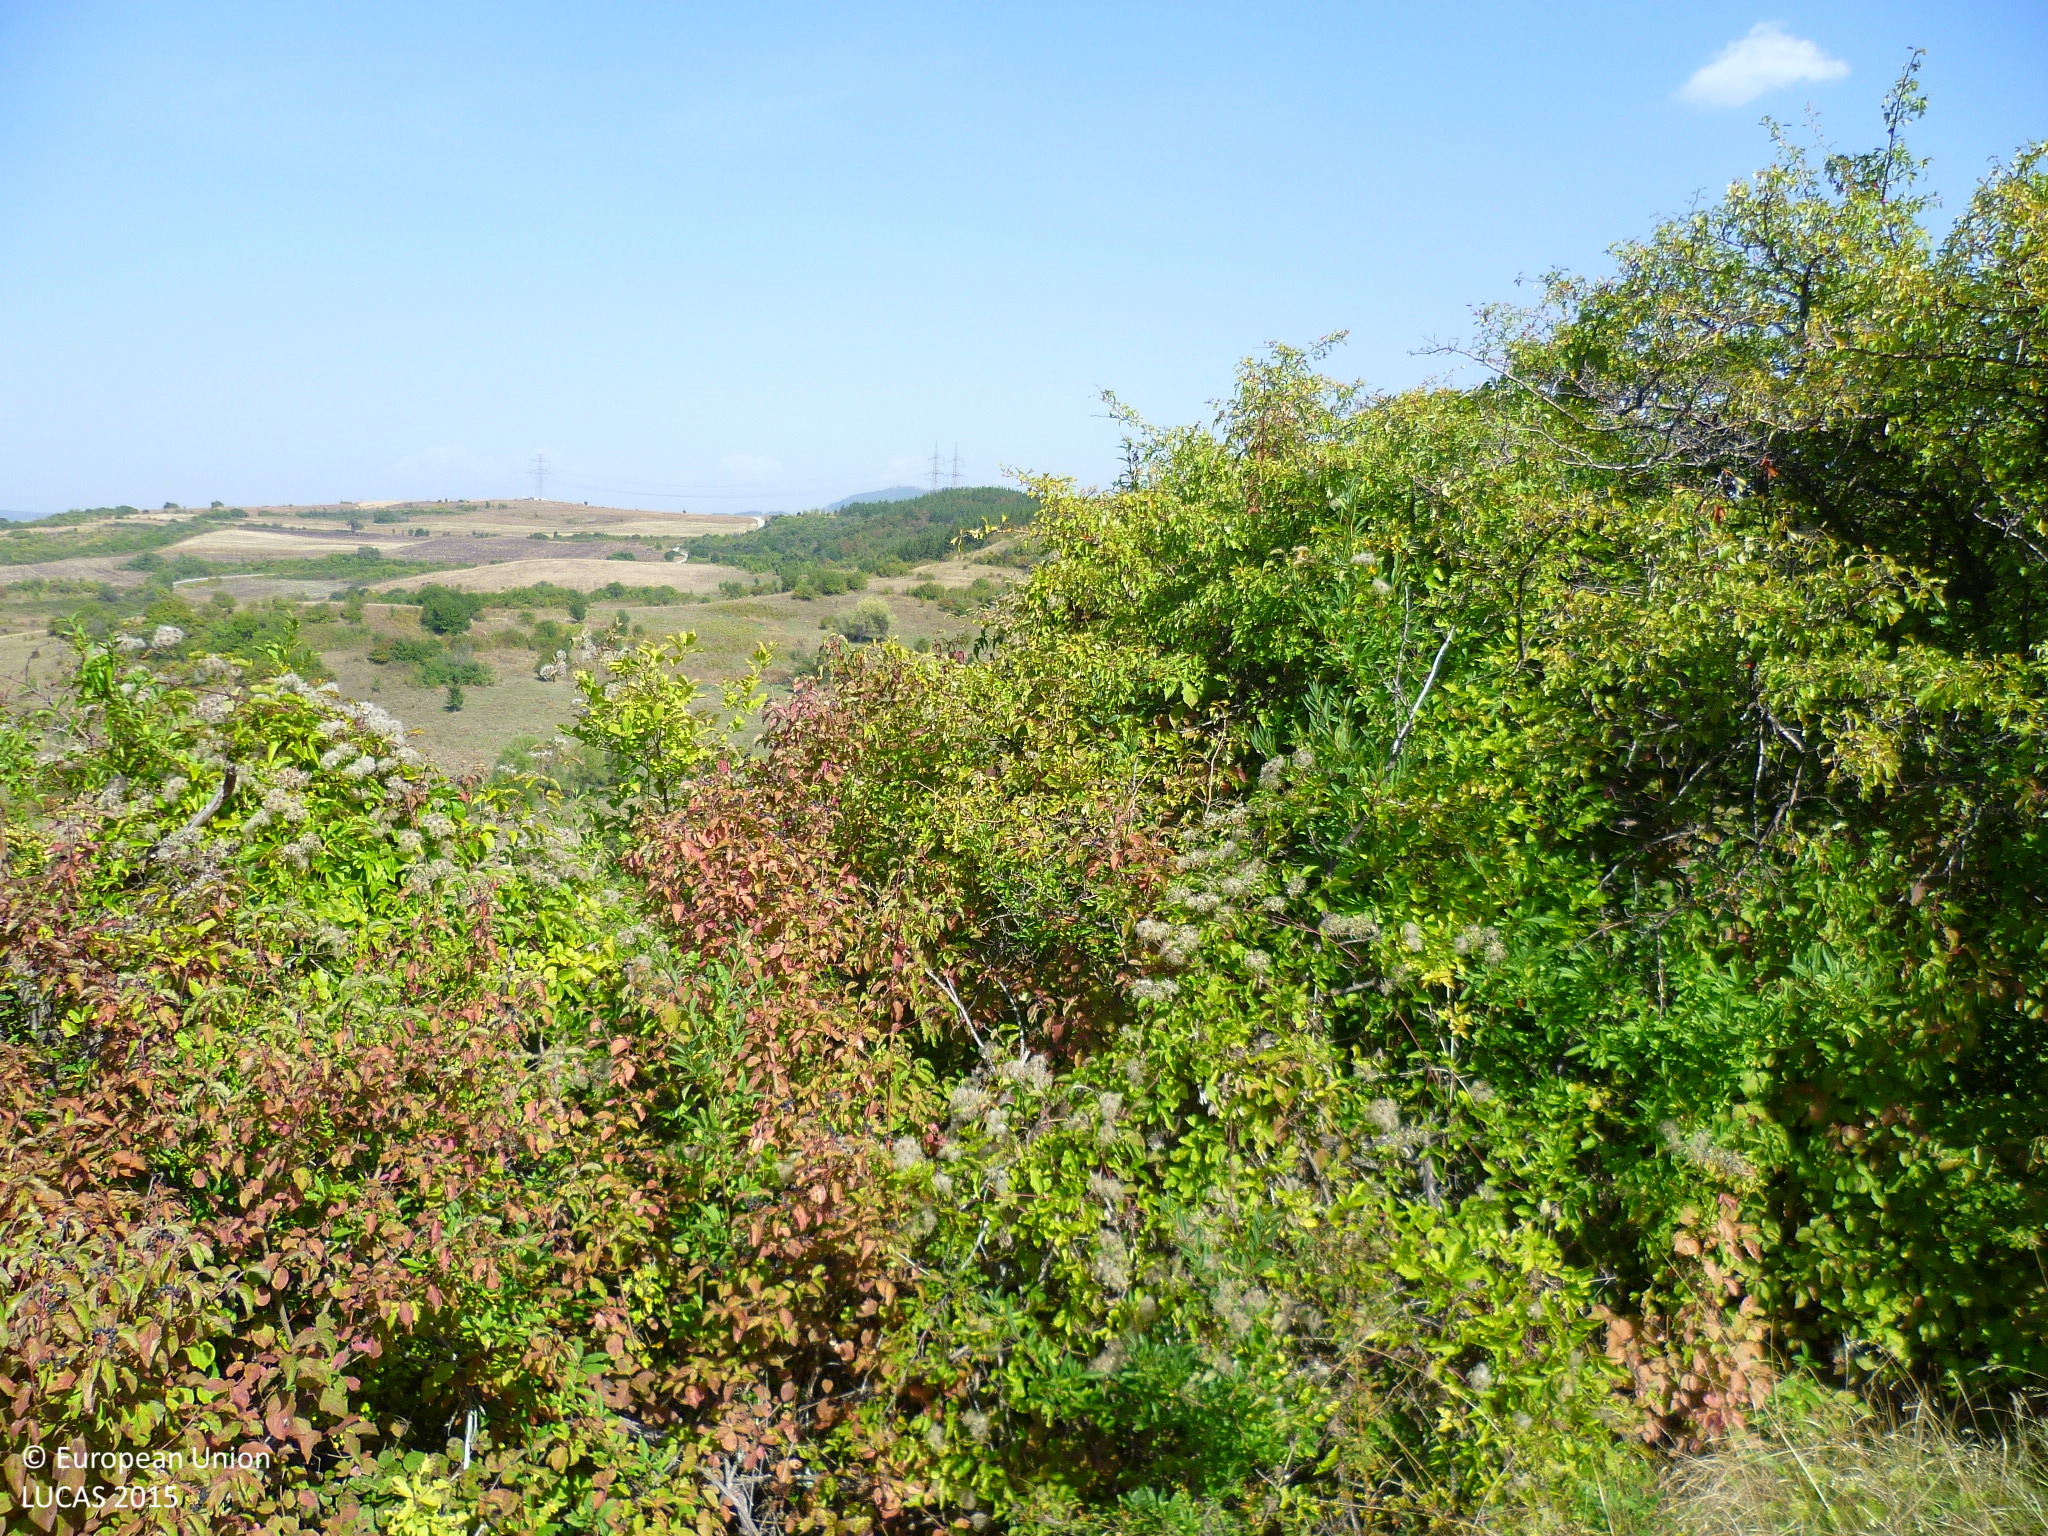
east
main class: Shrubland
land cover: Shrubland with sparse tree cover
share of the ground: 50 - 75 %
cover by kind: shrubs 65 %, herbaceous plants 30 %, broadleaved forest trees 5 %
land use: Semi-natural and natural areas not in use
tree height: < 5 m
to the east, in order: Shrubland with sparse tree cover; Broadleaved woodland; Grassland without tree/shrub cover; Grassland with sparse tree/shrub cover; Shrubland with sparse tree cover
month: September
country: BG
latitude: 42.6353
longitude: 22.9922
